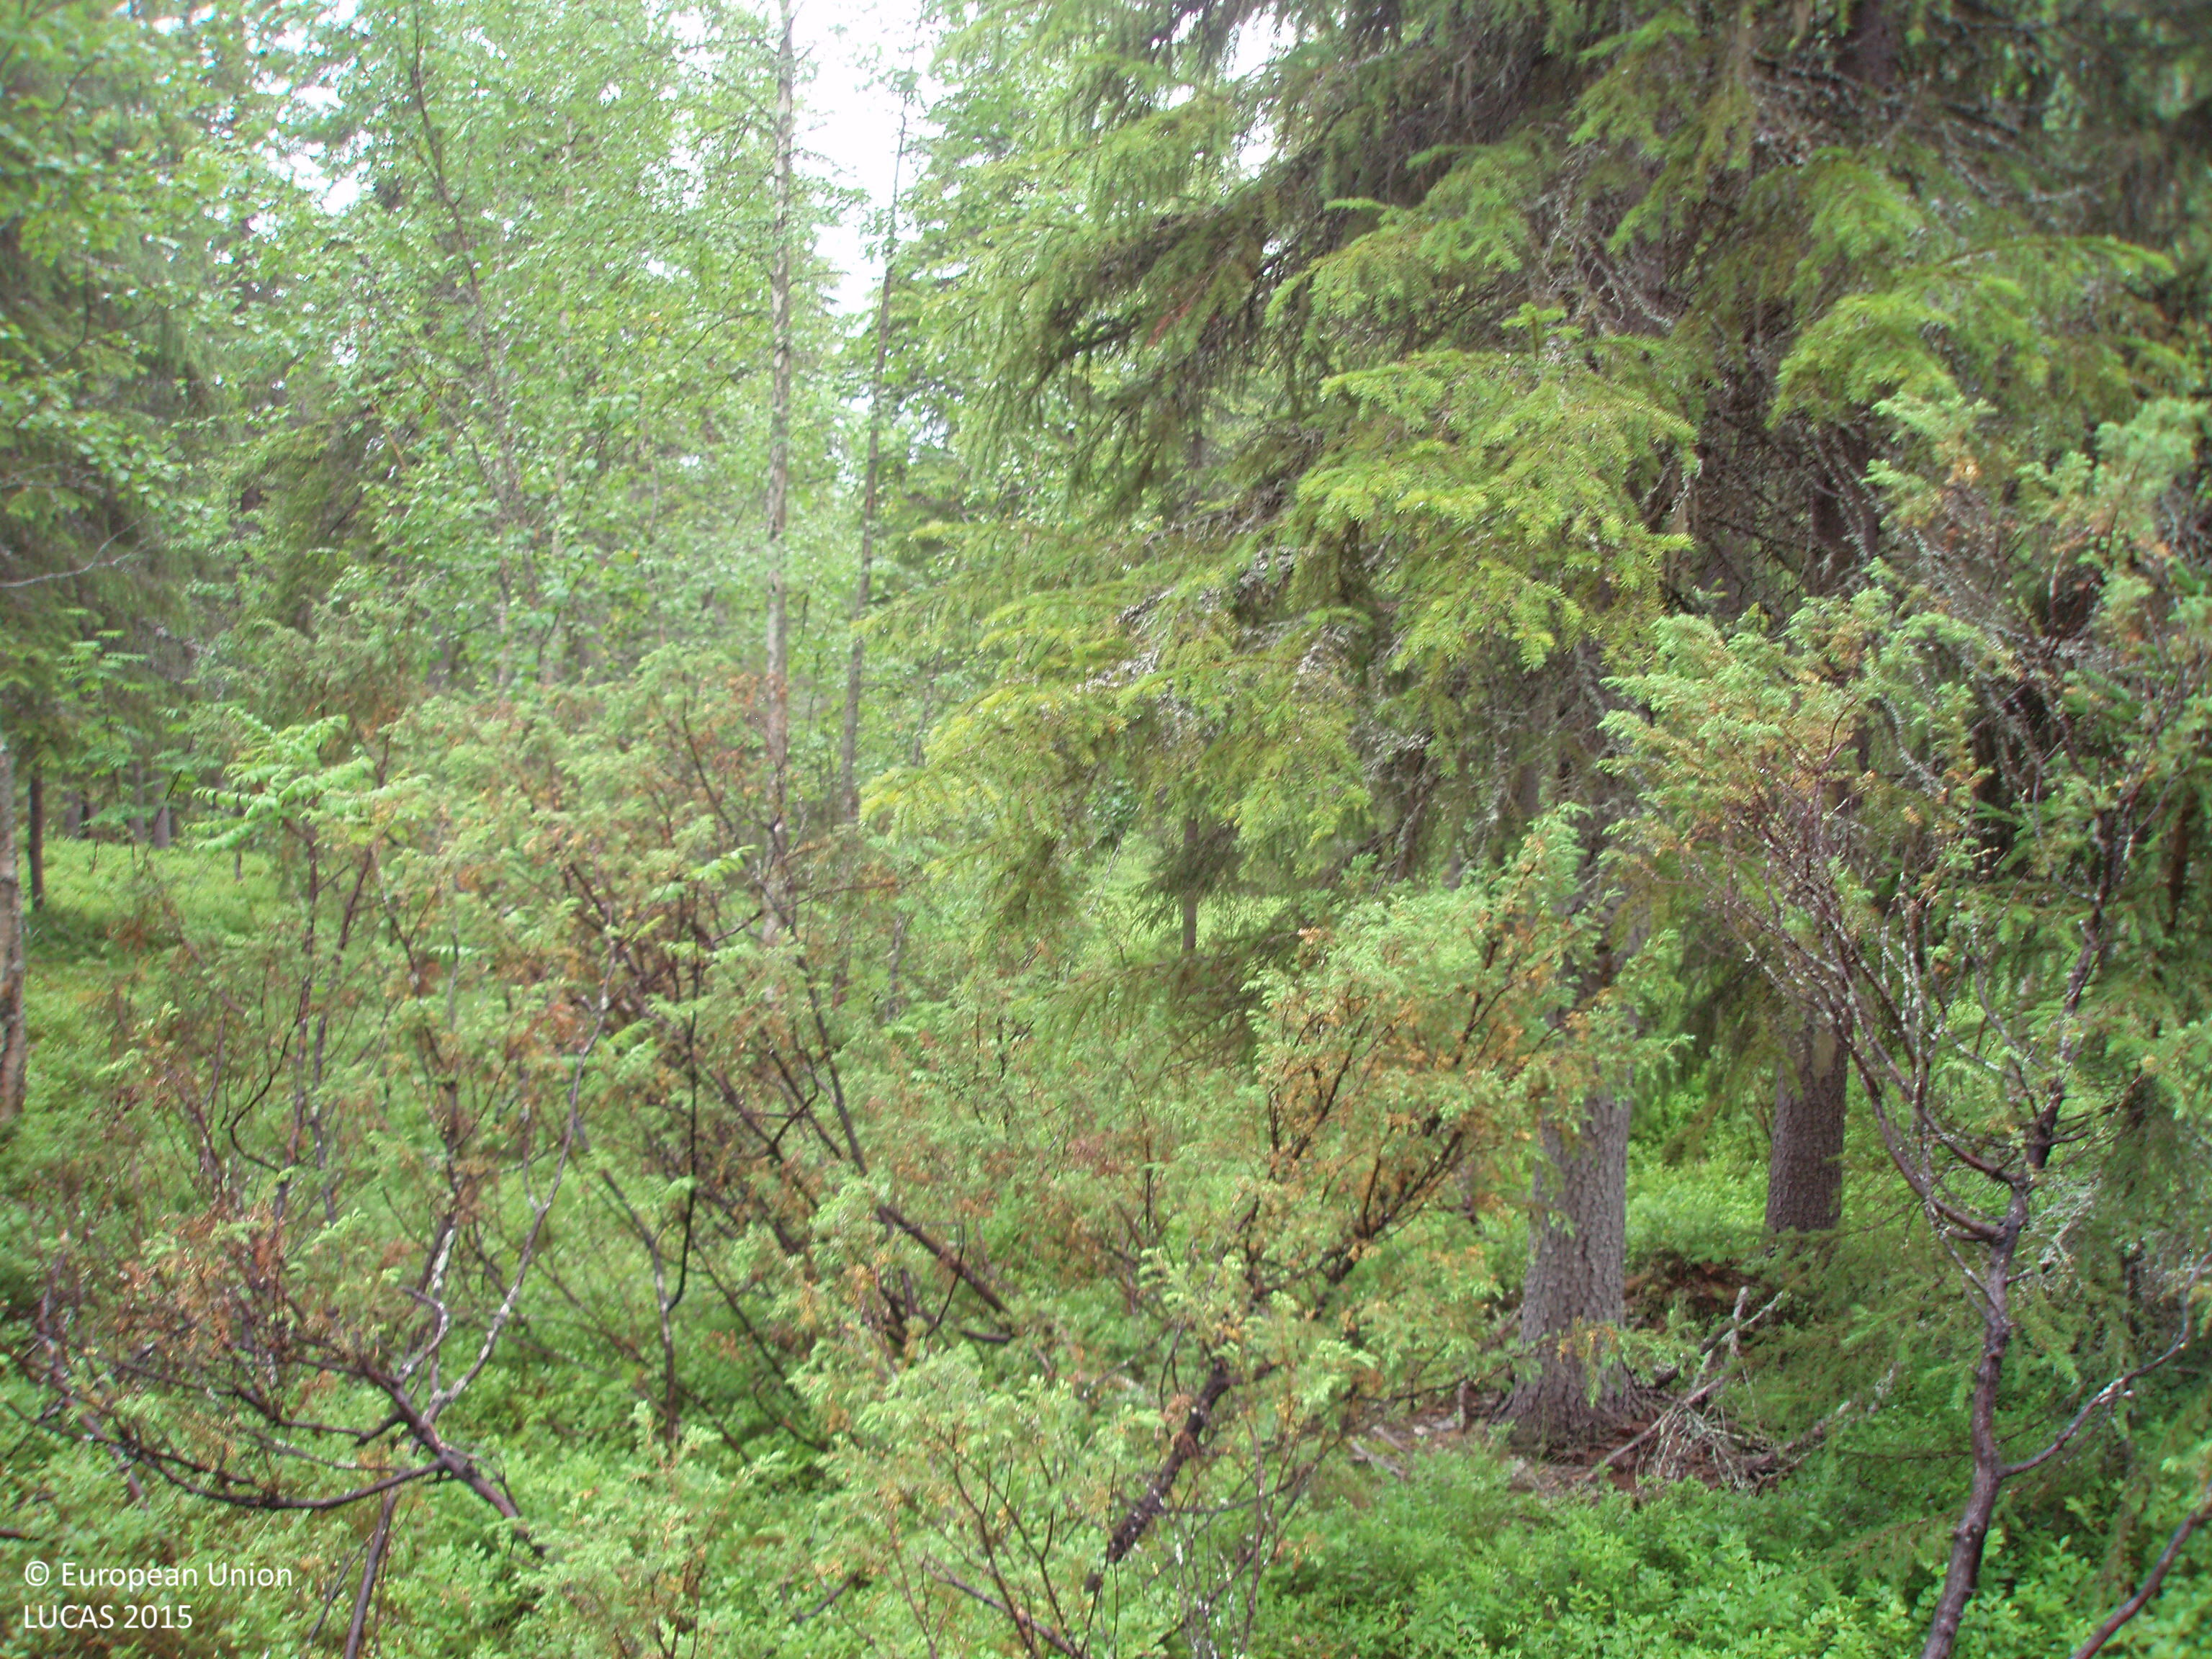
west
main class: Woodland
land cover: Spruce dominated mixed woodland
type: boreal forest
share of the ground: > 75 %
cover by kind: coniferous forest trees 40 %, broadleaved forest trees 35 %, shrubs 25 %
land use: Forestry
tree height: > 5 m
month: August
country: FI
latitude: 65.6310
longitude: 27.6603
